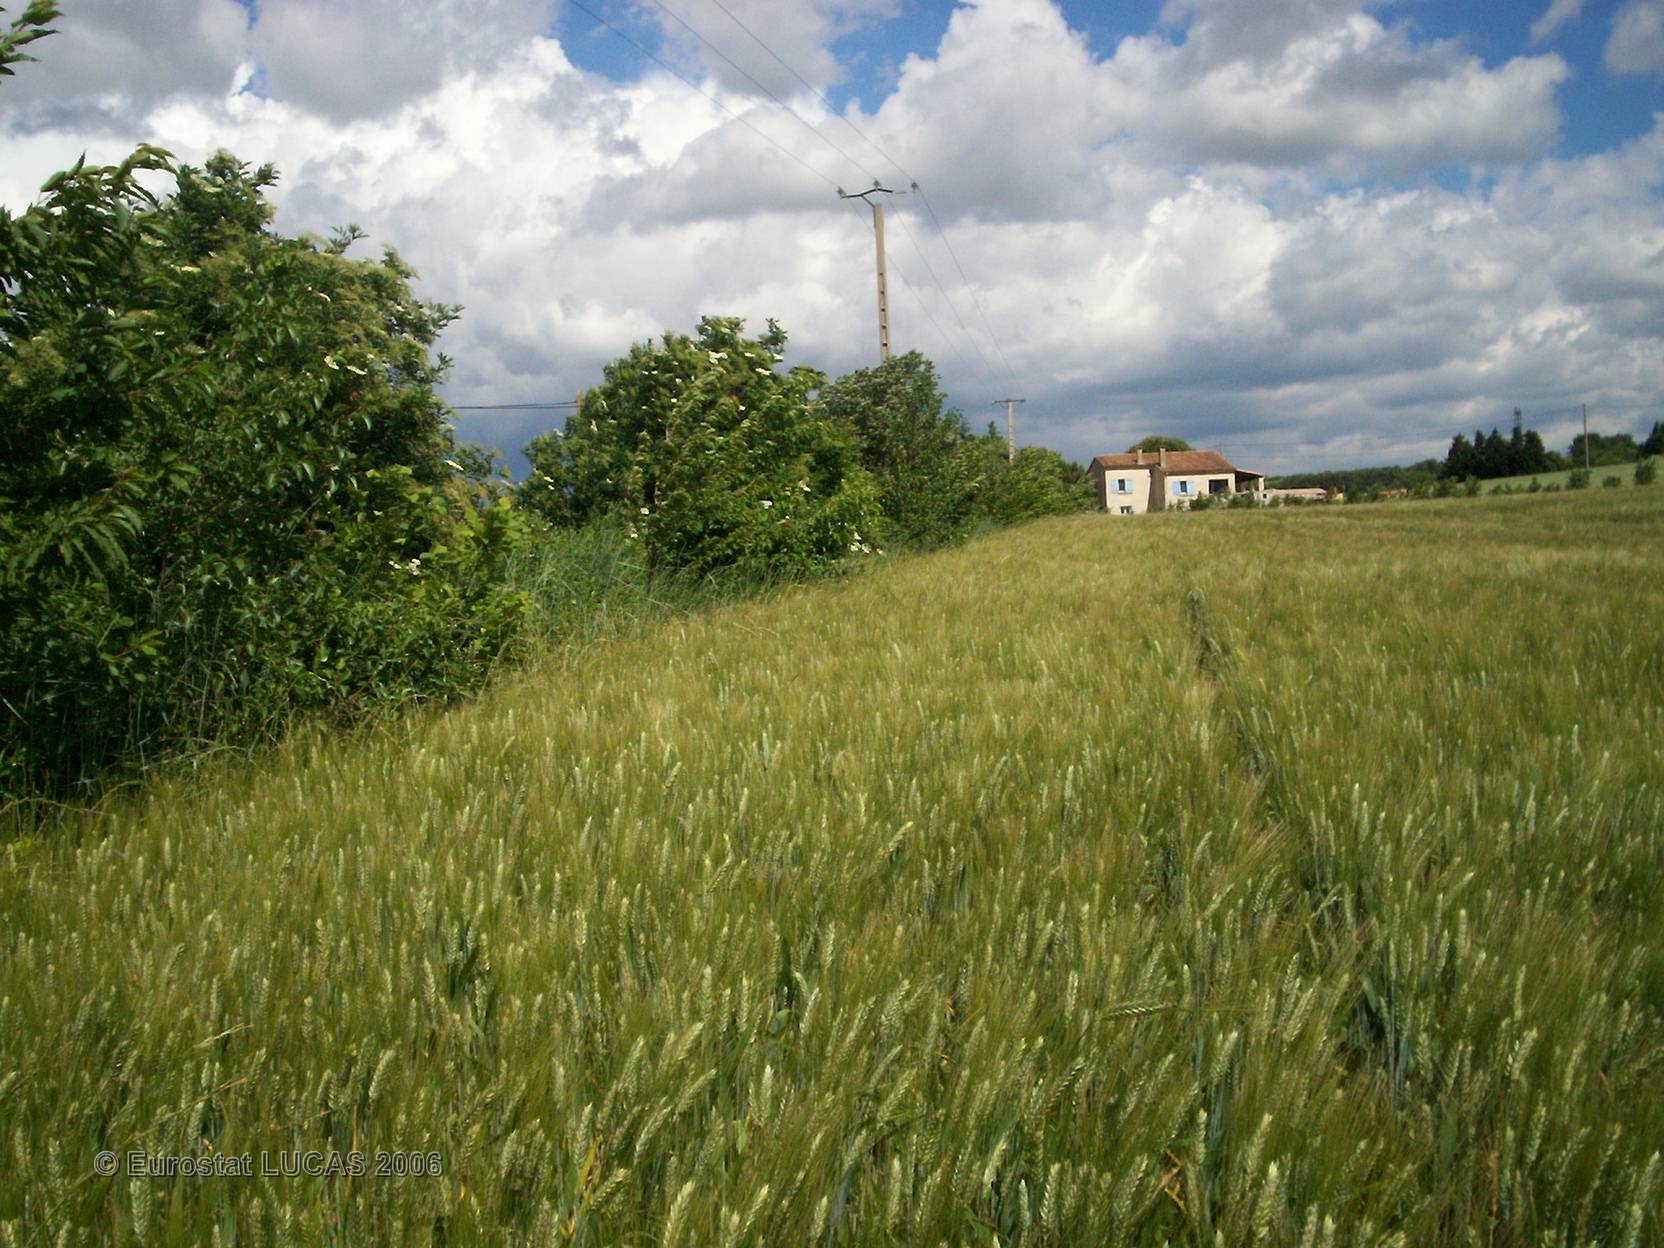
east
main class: Cropland
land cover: Durum wheat
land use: Agriculture (excluding fallow land and kitchen gardens)
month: May
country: FR
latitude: 44.5651
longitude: 4.8318
